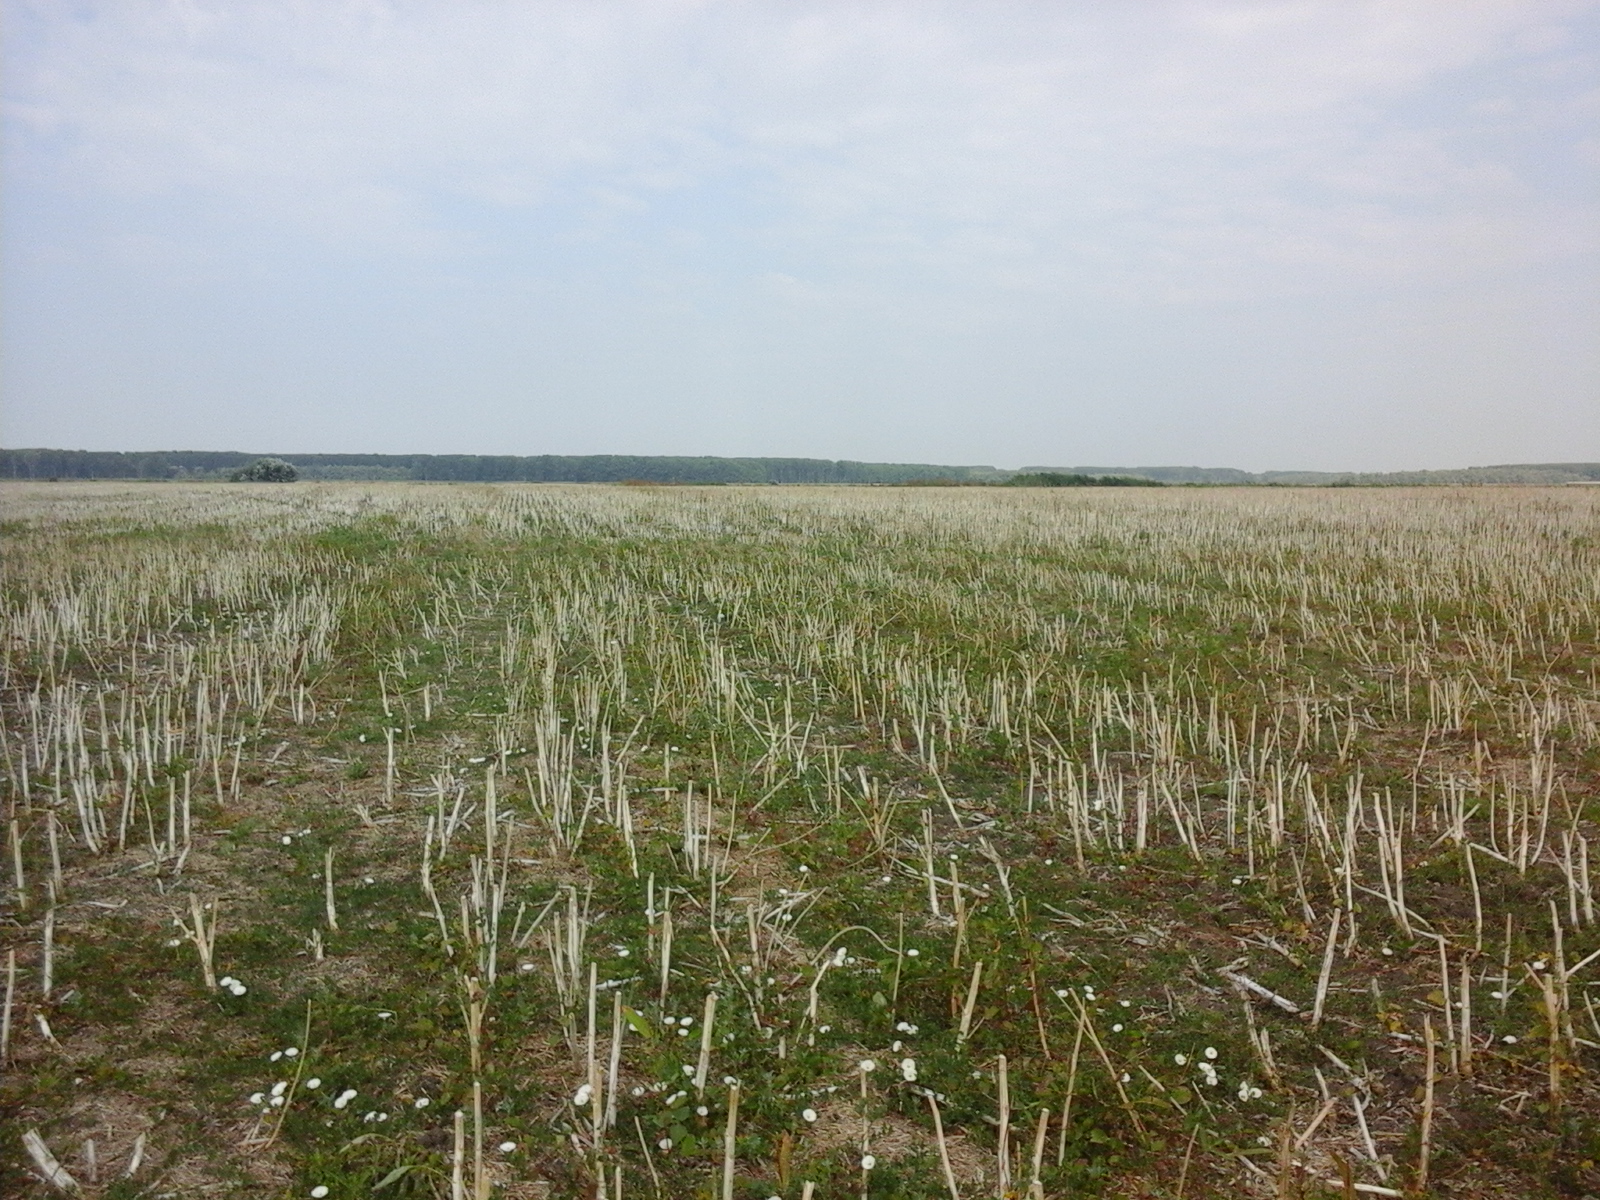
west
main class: Cropland
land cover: Rape and turnip rape
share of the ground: > 75 %
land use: Agriculture (excluding fallow land and kitchen gardens)
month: July
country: RO
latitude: 44.5024
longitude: 27.9536
